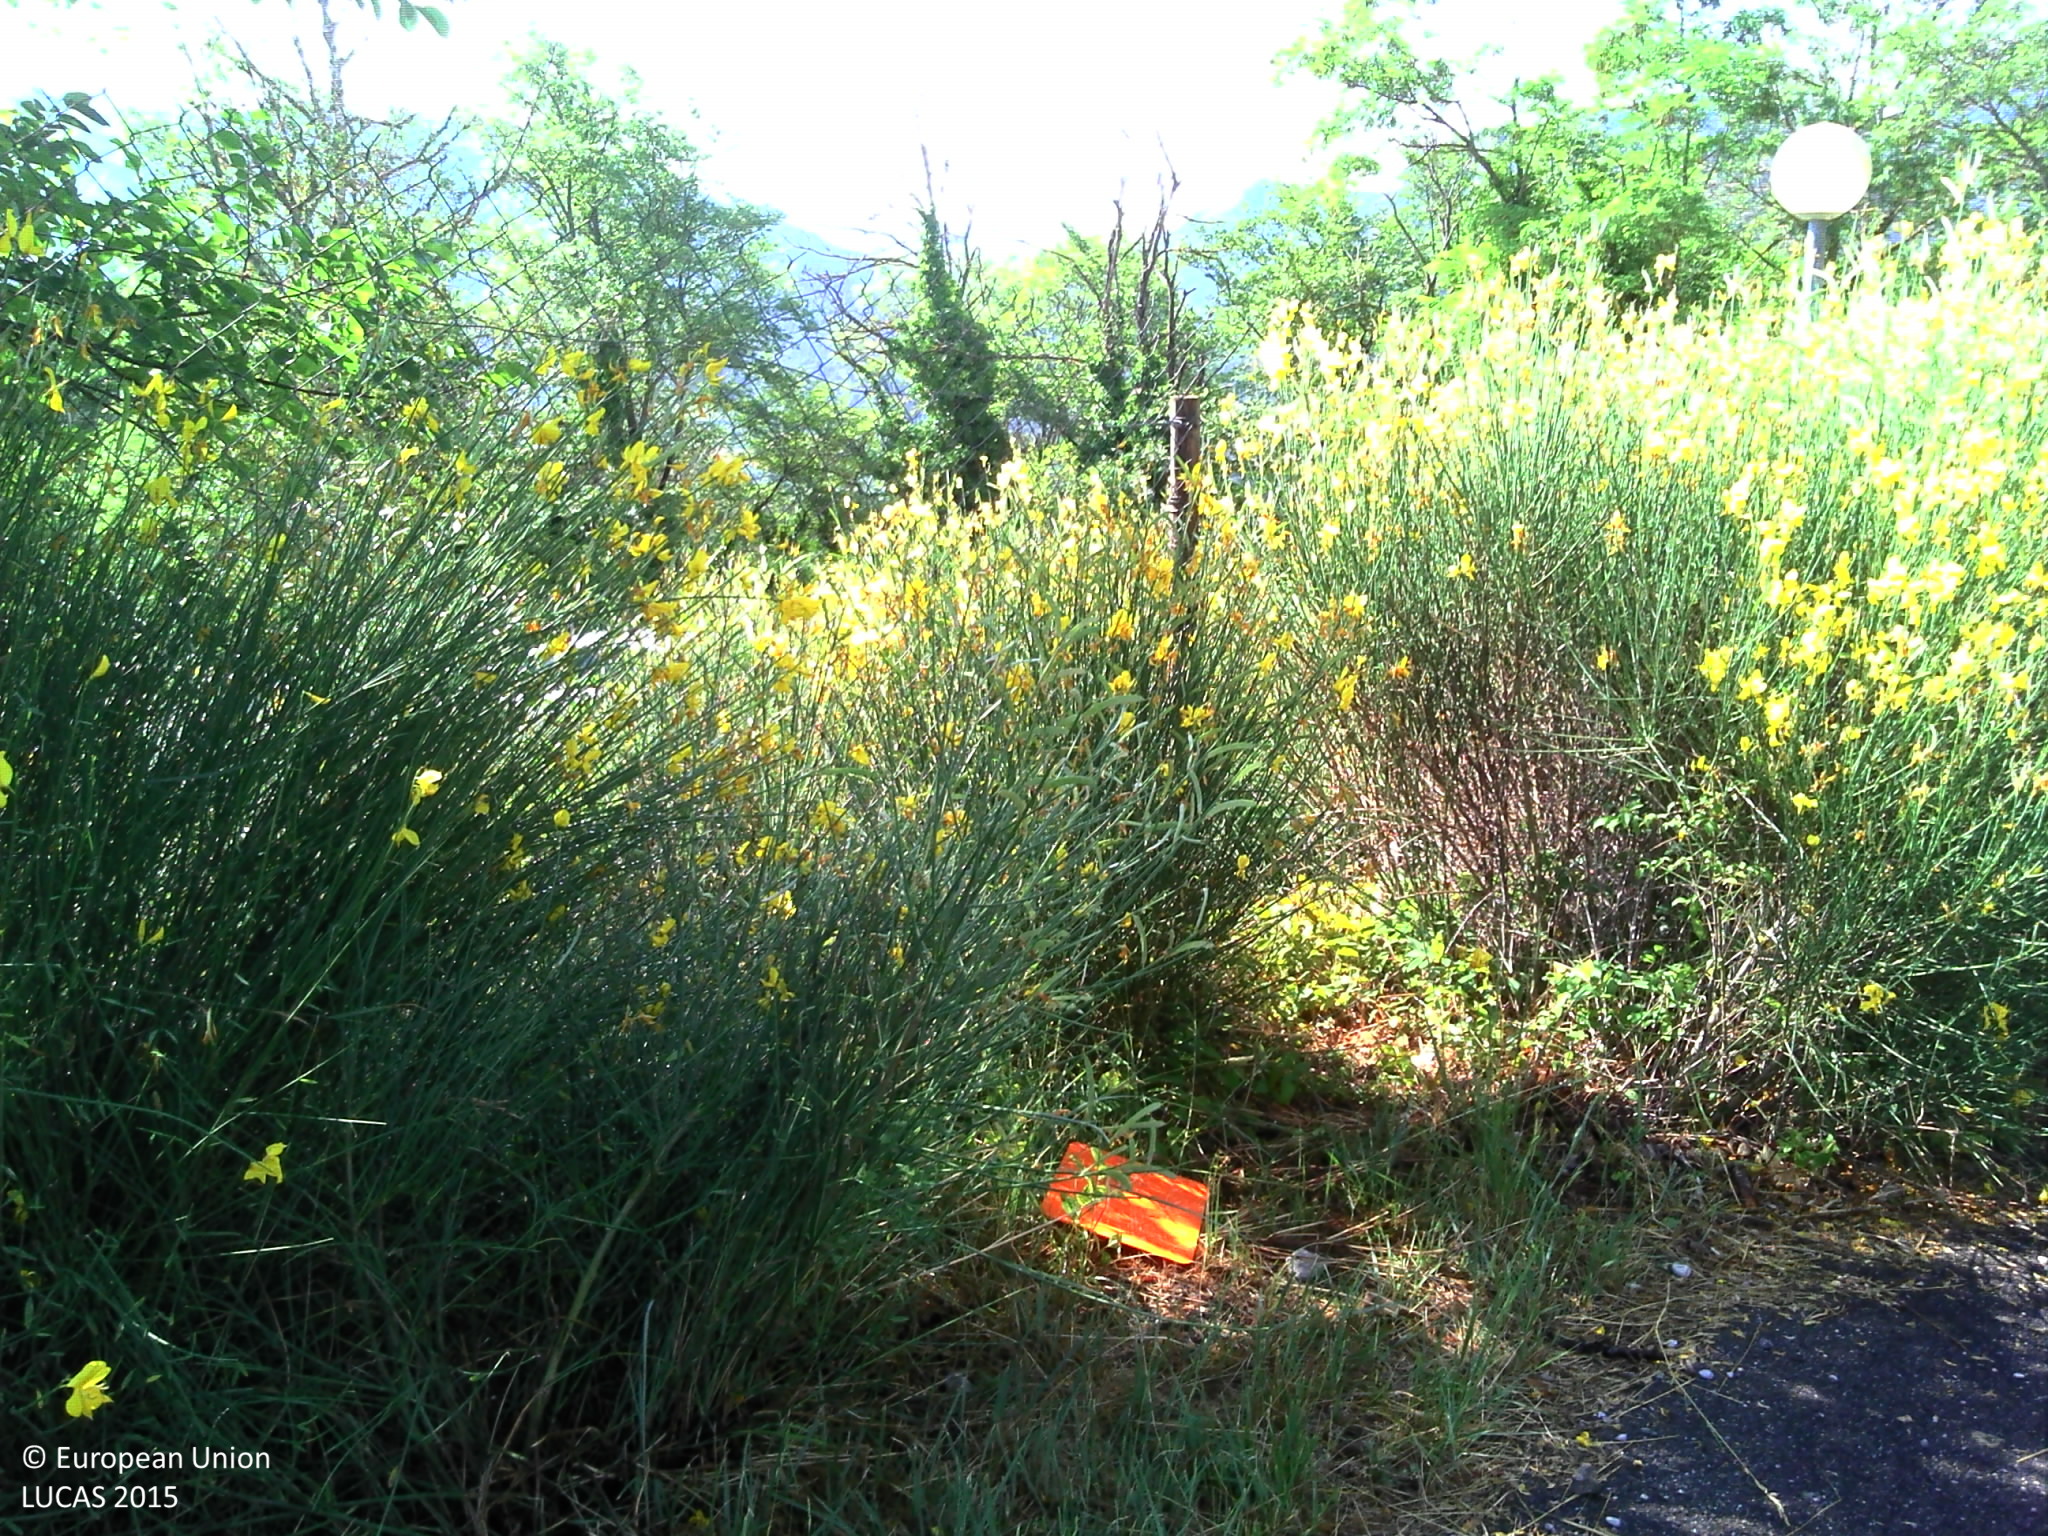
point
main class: Shrubland
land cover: Shrubland with sparse tree cover
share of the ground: > 75 %
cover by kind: herbaceous plants 85 %, shrubs 10 %, broadleaved forest trees 5 %
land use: Residential
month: June
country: FR
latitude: 44.7113
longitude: 5.2477
